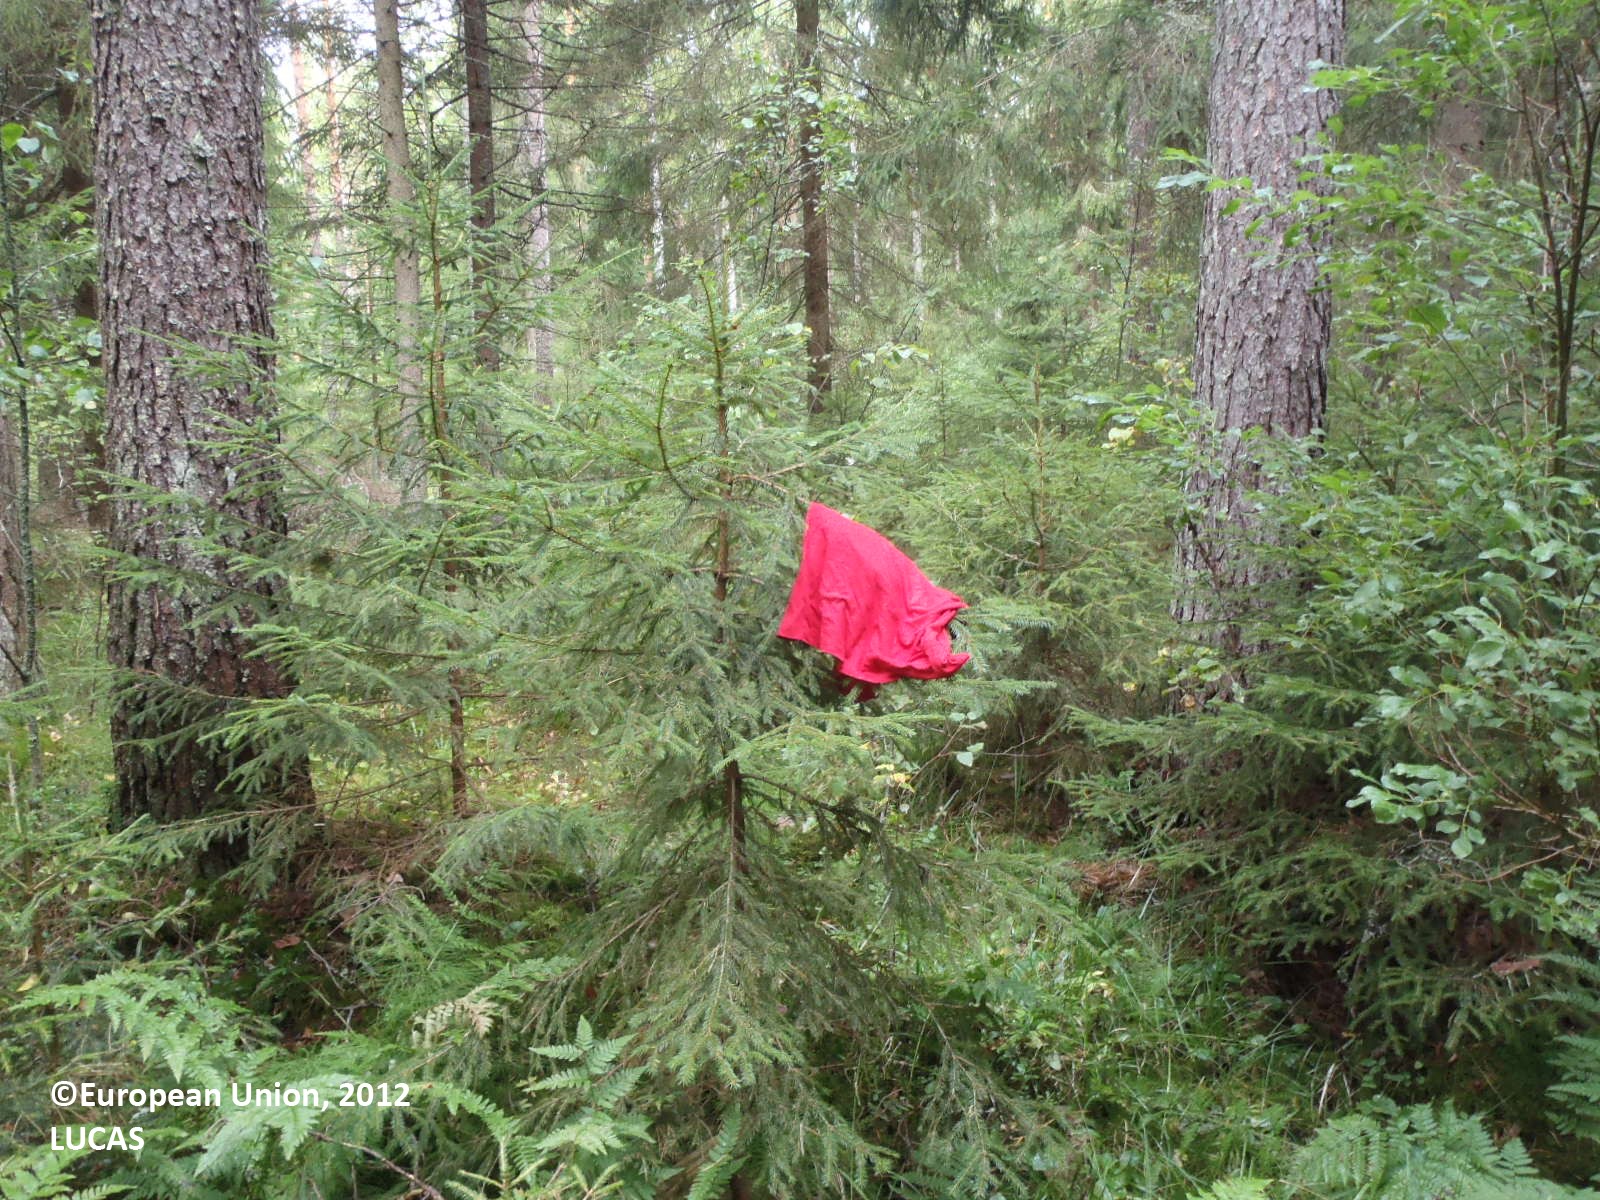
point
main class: Woodland
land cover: Spruce dominated coniferous woodland
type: boreal forest
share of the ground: > 75 %
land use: Forestry
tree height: > 5 m
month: August
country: FI
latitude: 60.6604
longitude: 22.5292
